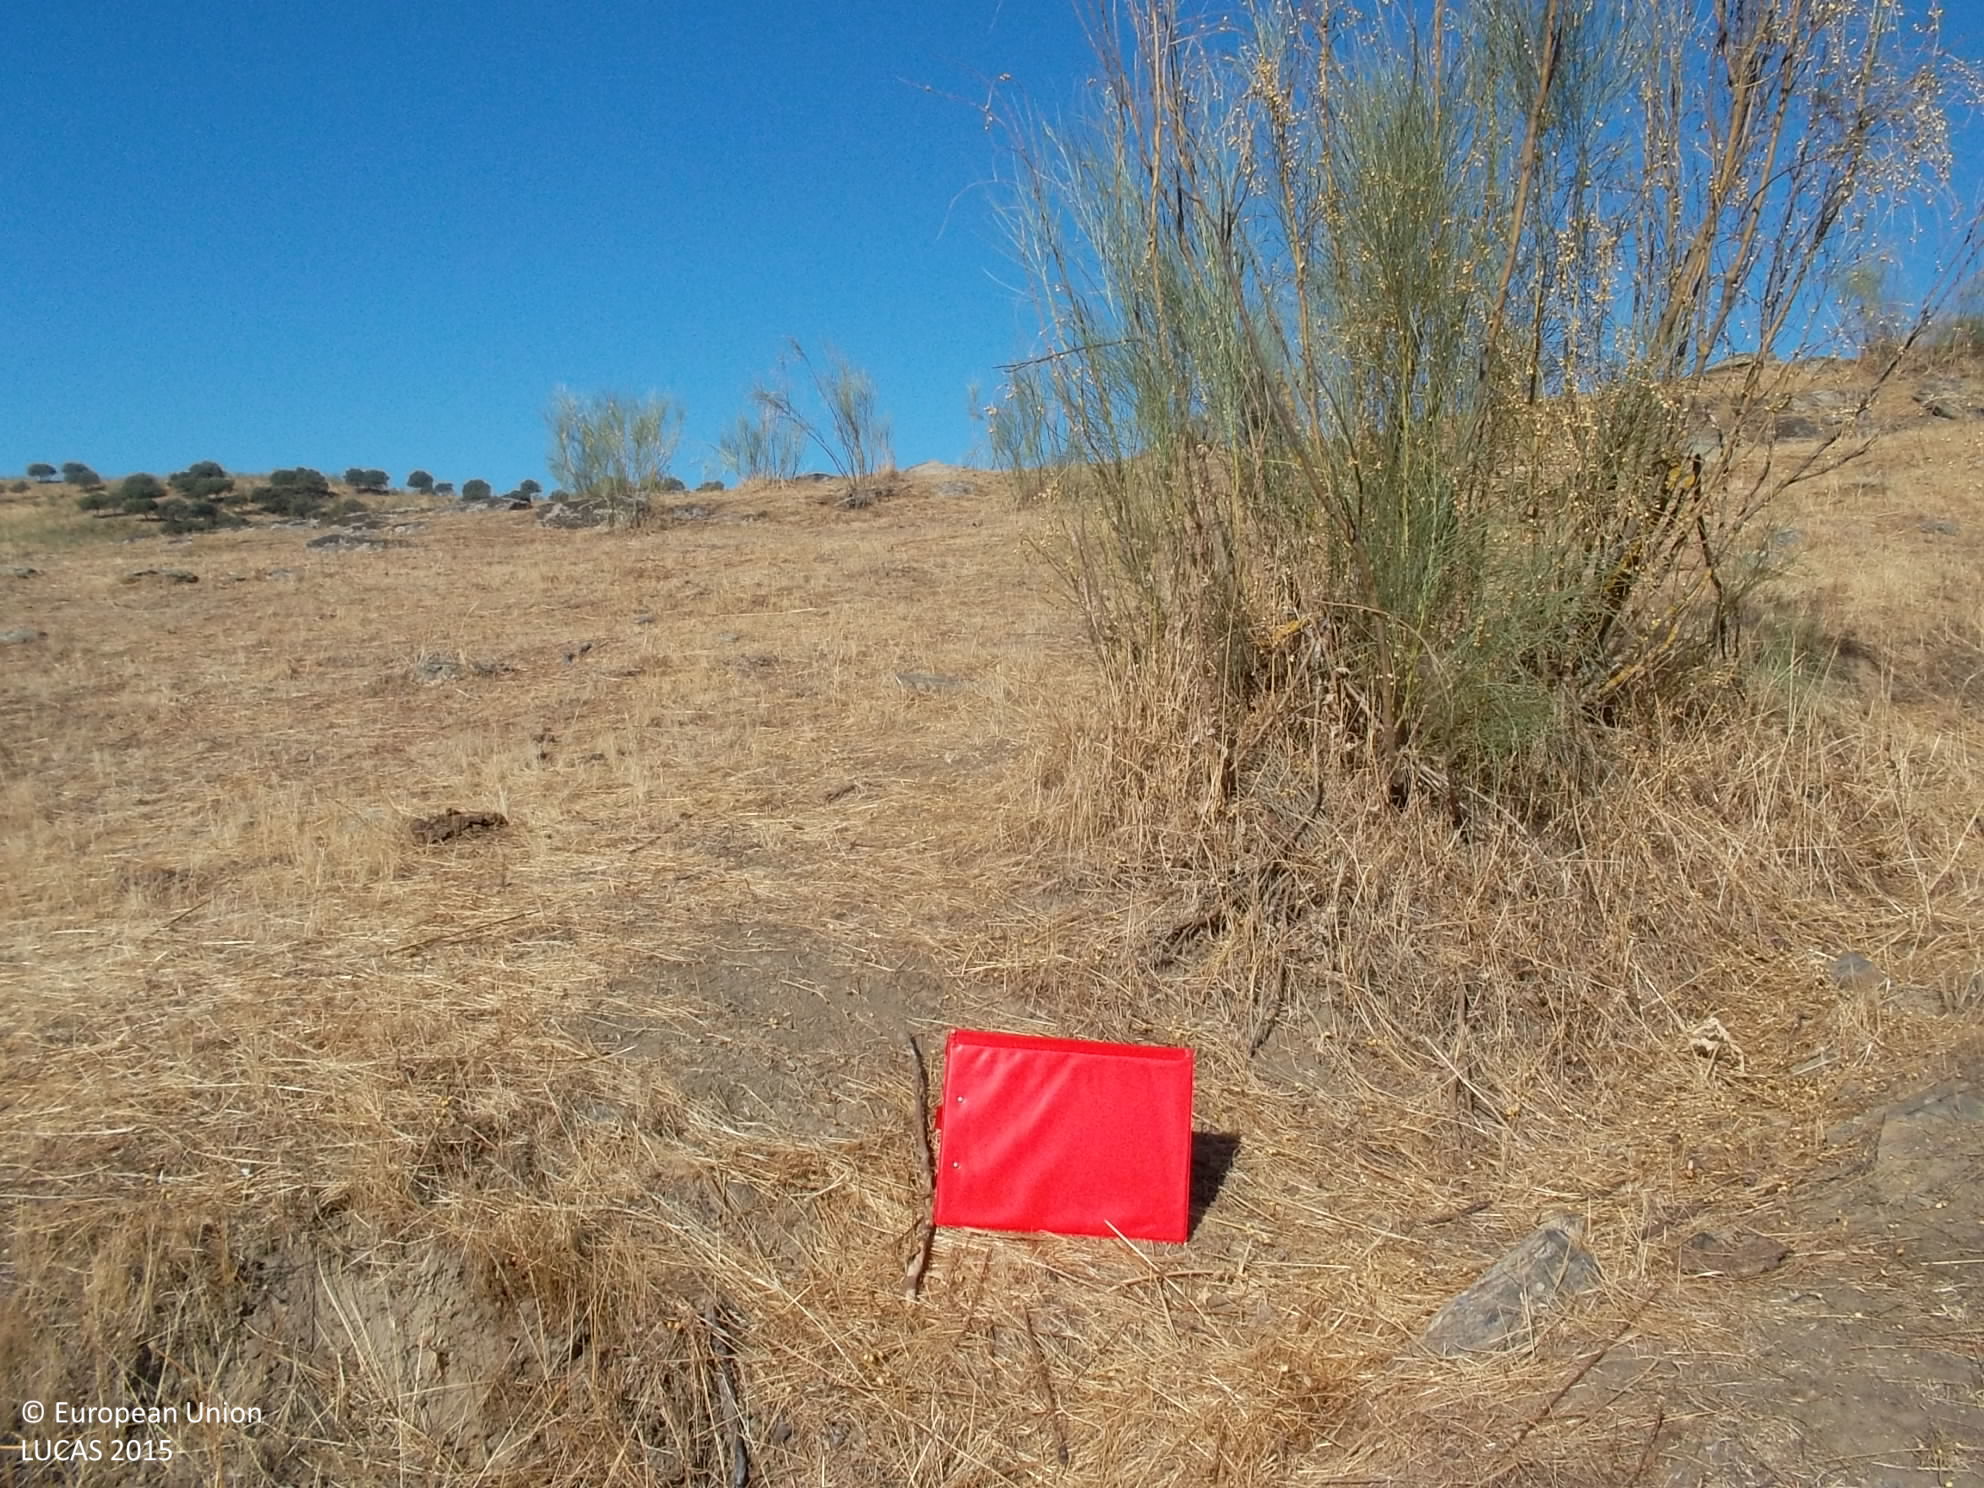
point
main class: Shrubland
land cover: Shrubland without tree cover
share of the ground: > 75 %
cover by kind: shrubs 50 %, herbaceous plants 50 %
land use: Agriculture (excluding fallow land and kitchen gardens)
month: August
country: ES
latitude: 38.2662
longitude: -6.7292
